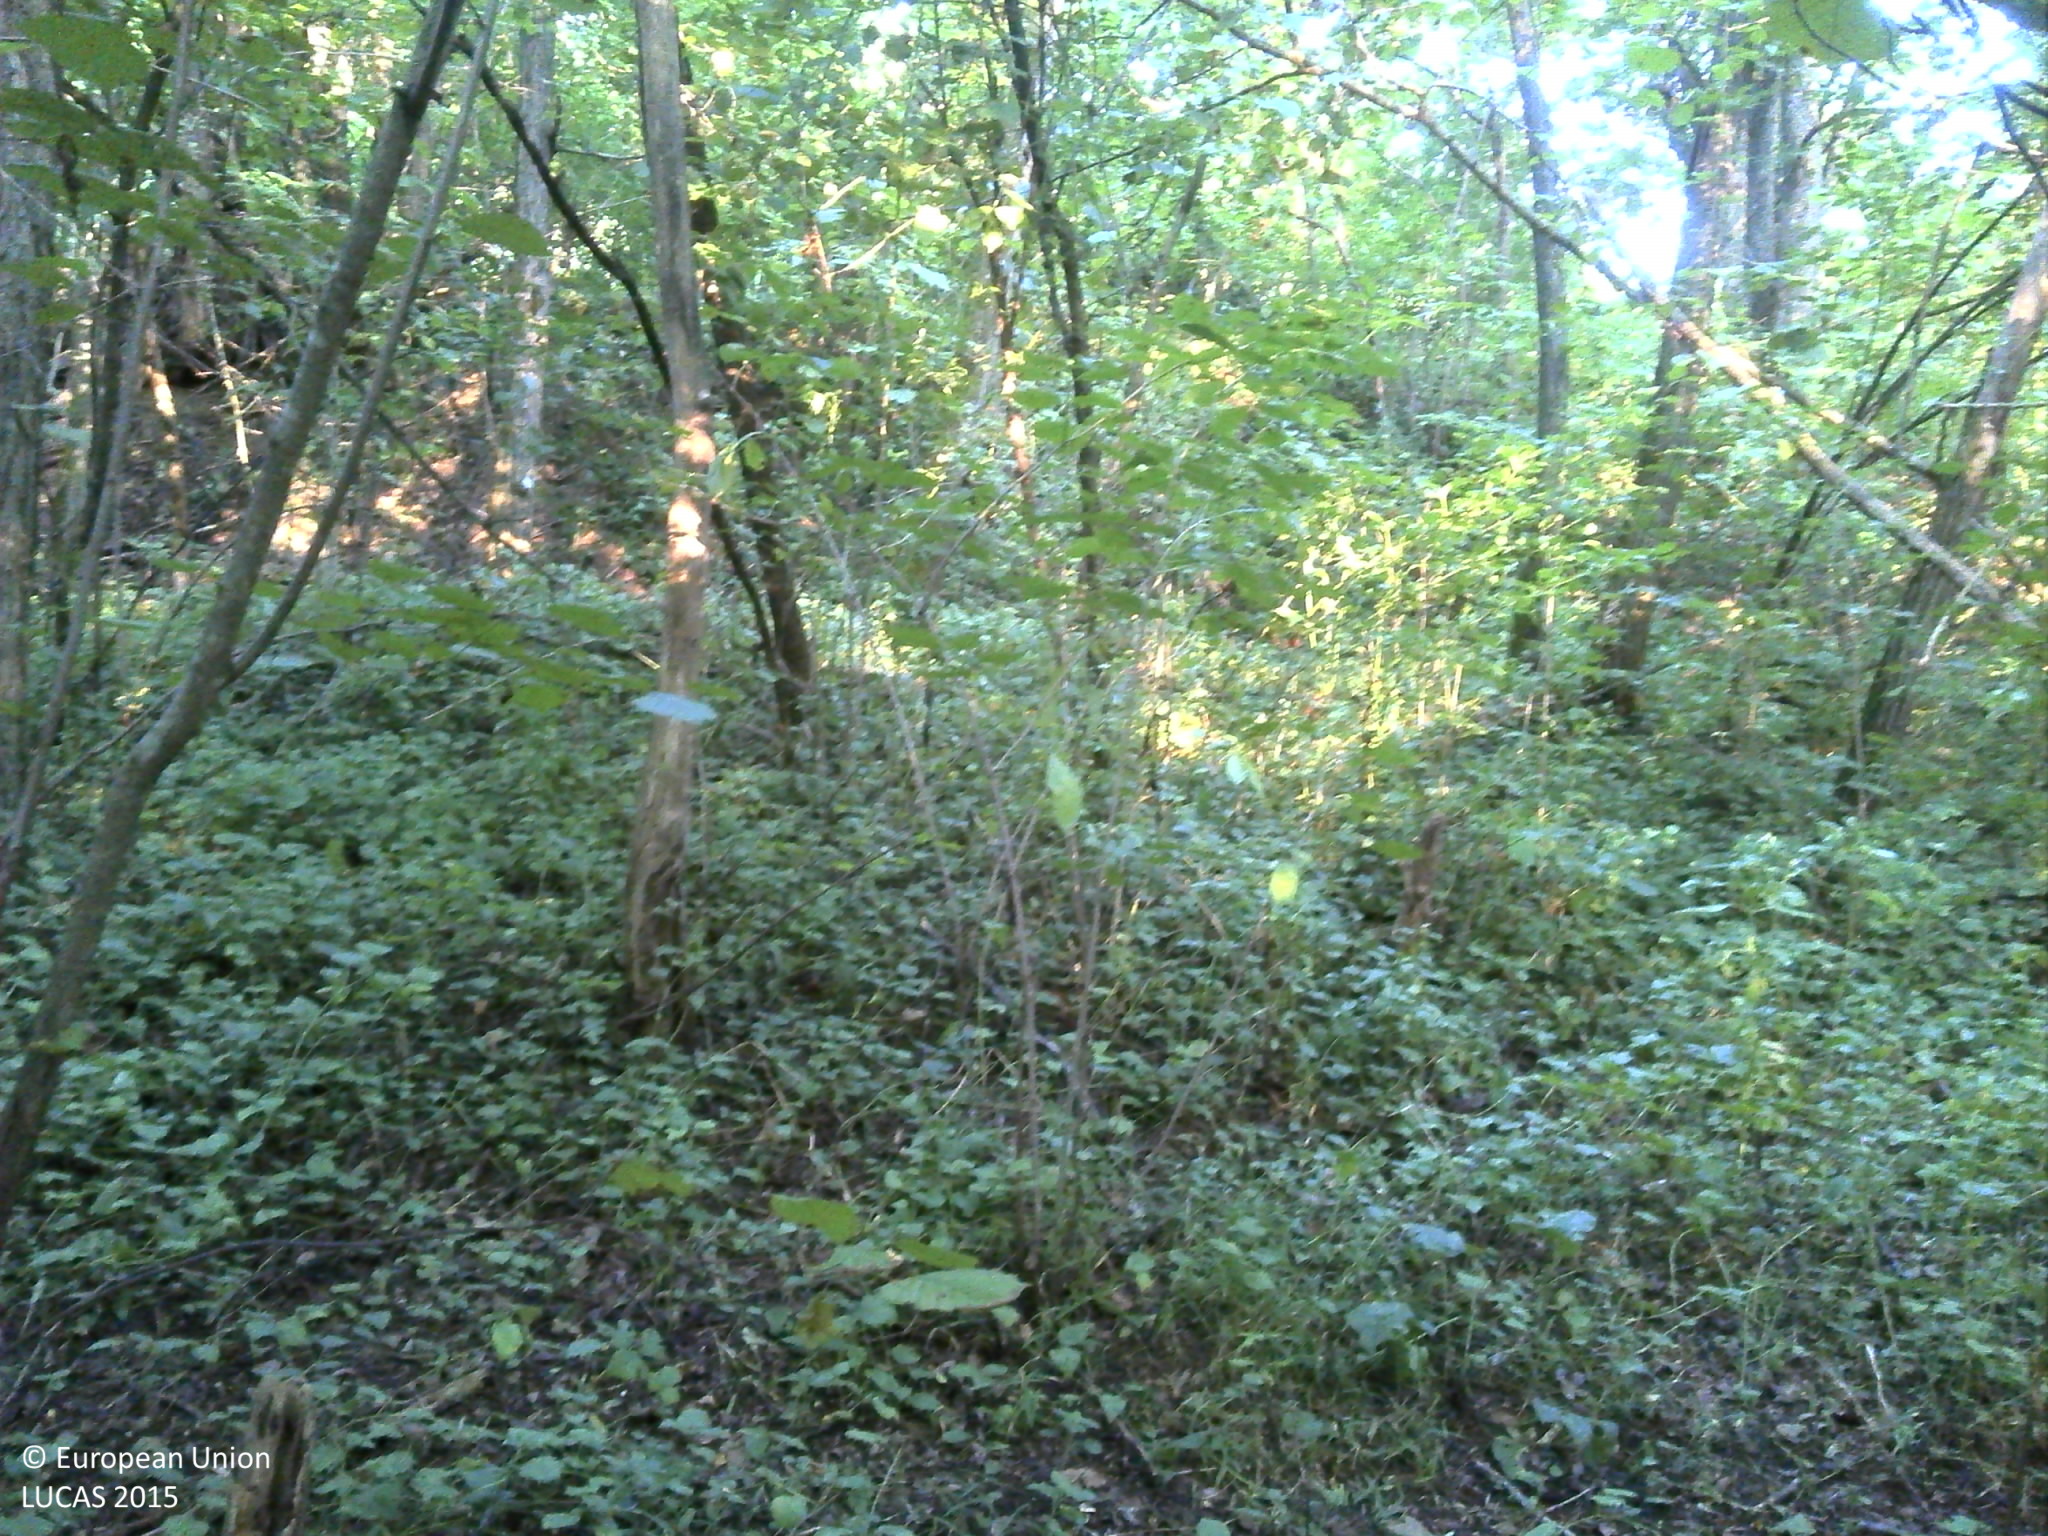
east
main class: Woodland
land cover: Broadleaved woodland
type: acidophilous oak and oak-birch forest
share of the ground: > 75 %
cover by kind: broadleaved forest trees 100 %
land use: Forestry
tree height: > 5 m
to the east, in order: Broadleaved woodland; Grassland without tree/shrub cover; Broadleaved woodland; Grassland without tree/shrub cover
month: August
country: HR
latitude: 45.3575
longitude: 16.2138
